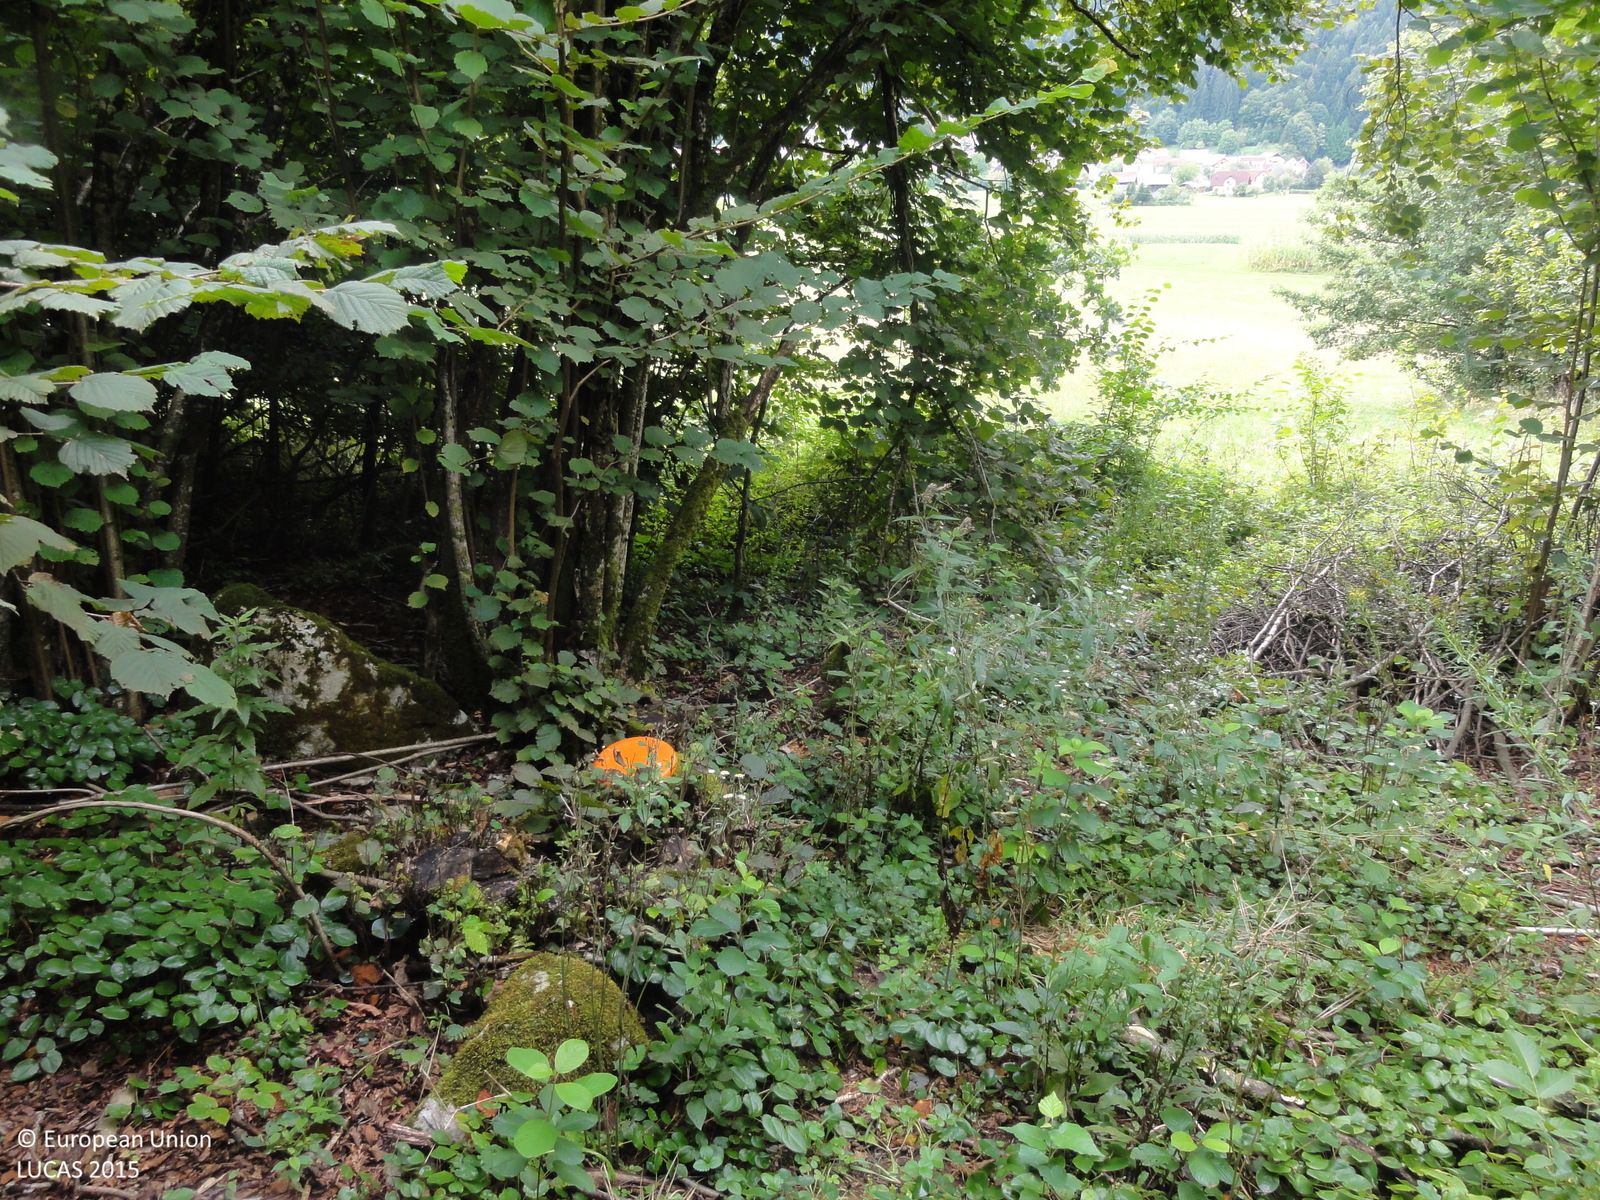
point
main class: Woodland
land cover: Broadleaved woodland
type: beech forest
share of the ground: 25 - 50 %
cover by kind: shrubs 70 %, broadleaved forest trees 30 %
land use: Forestry
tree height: > 5 m
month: August
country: SI
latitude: 45.7448
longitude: 15.0477
